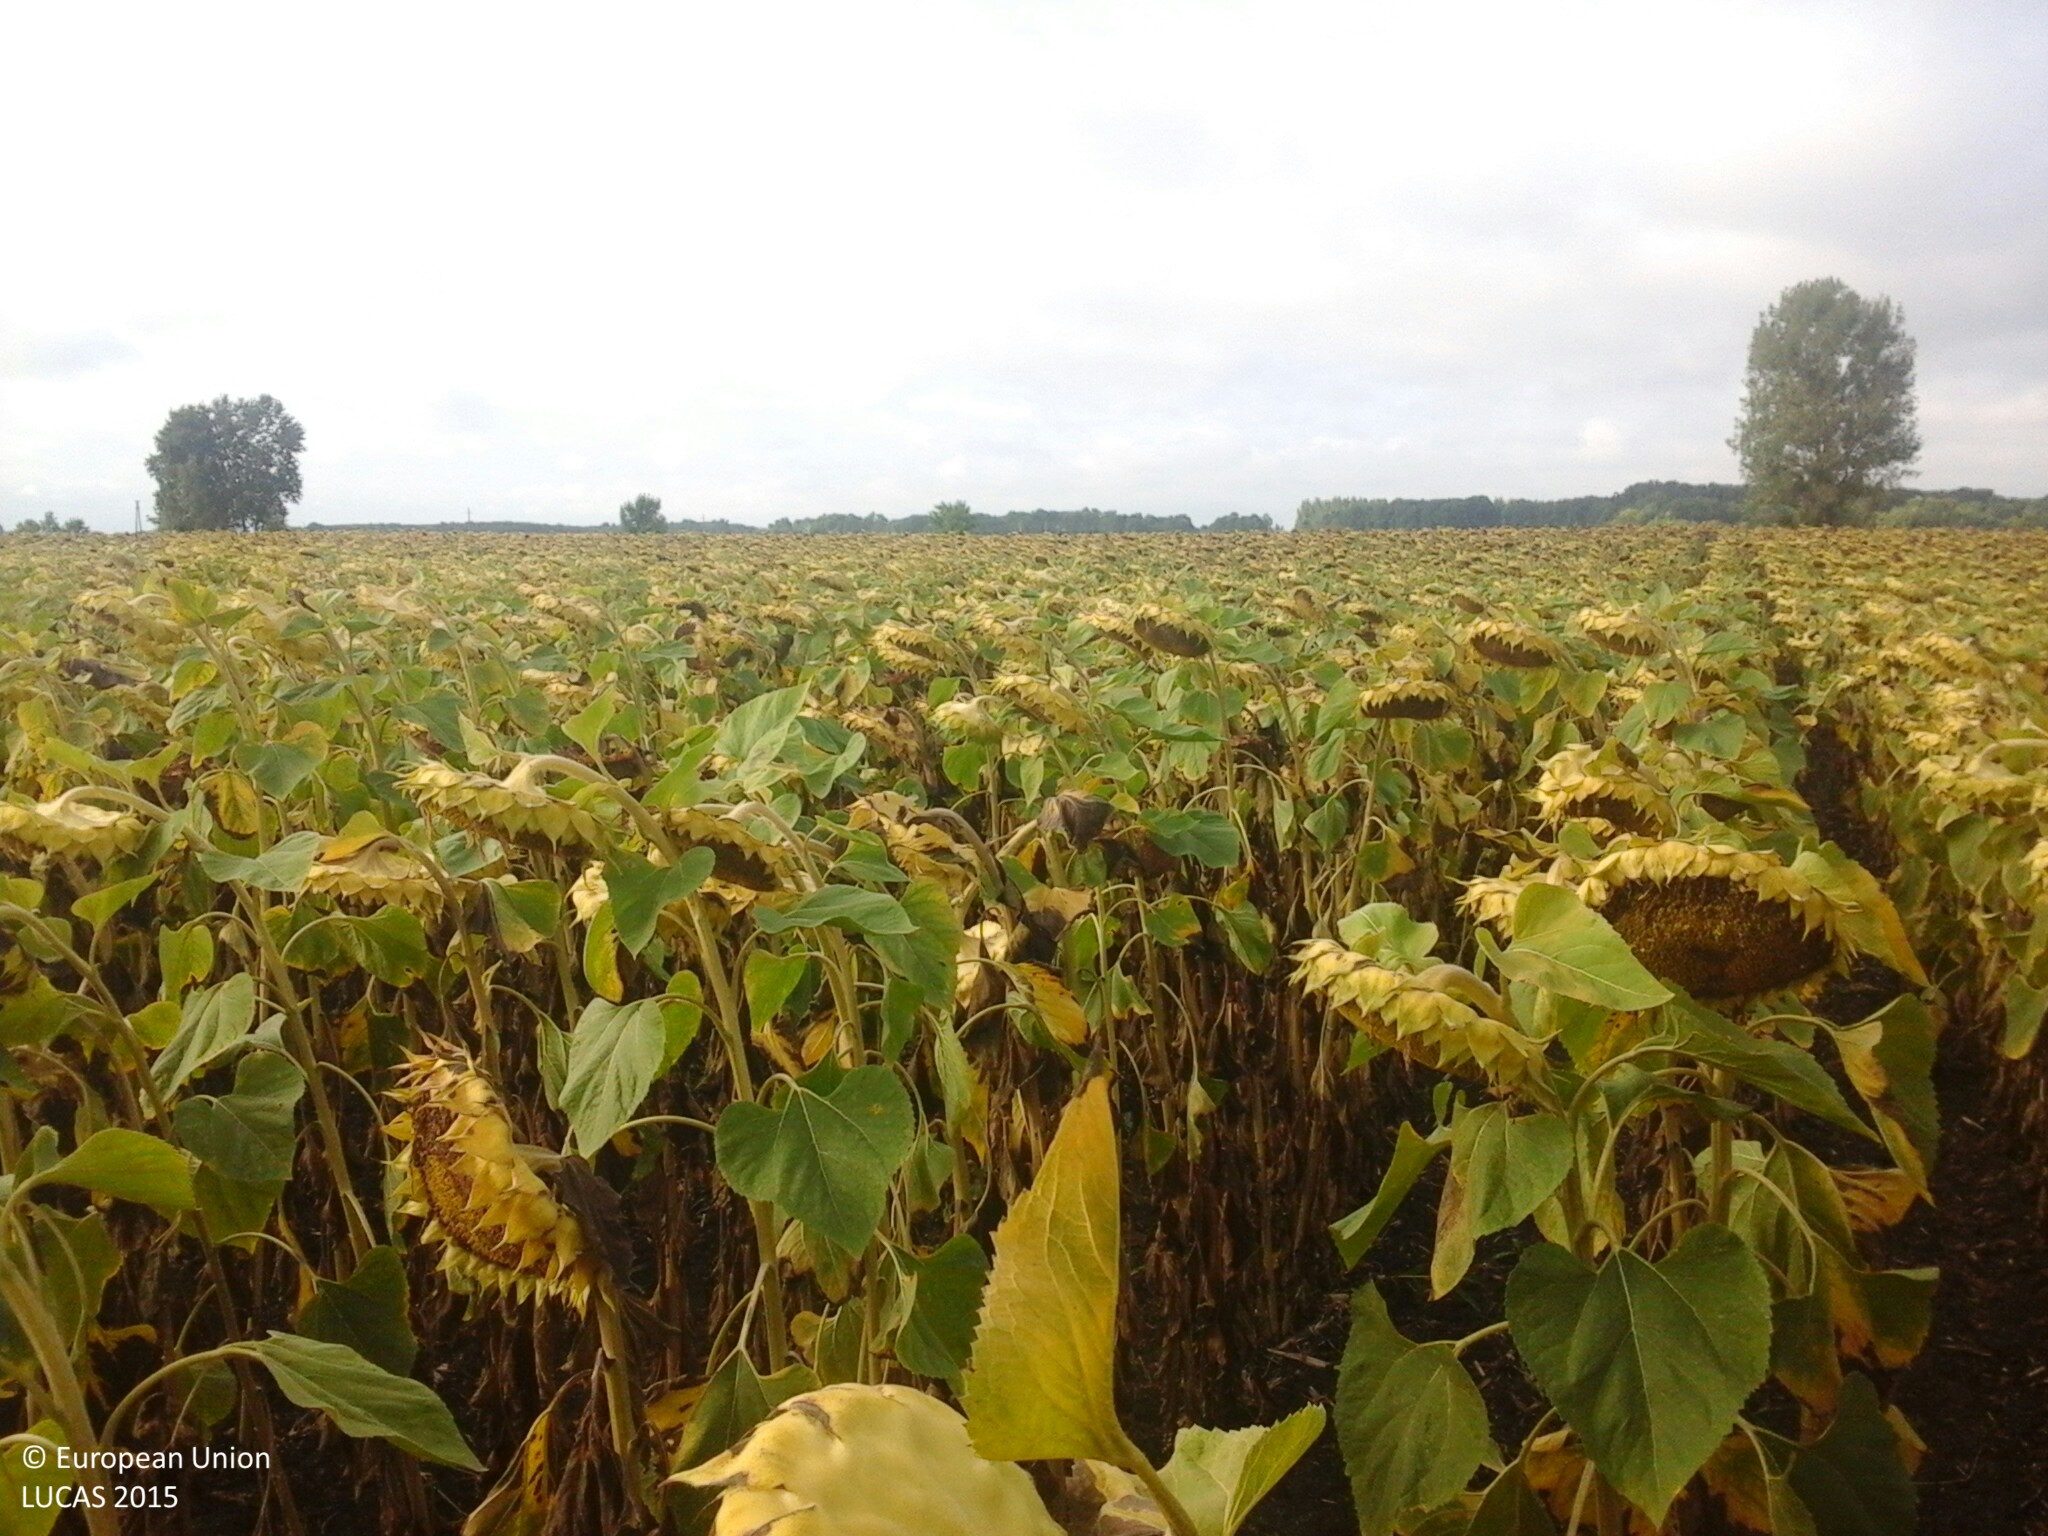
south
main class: Cropland
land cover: Sunflower
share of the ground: > 75 %
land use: Agriculture (excluding fallow land and kitchen gardens)
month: August
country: HU
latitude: 47.0618
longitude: 21.6153
